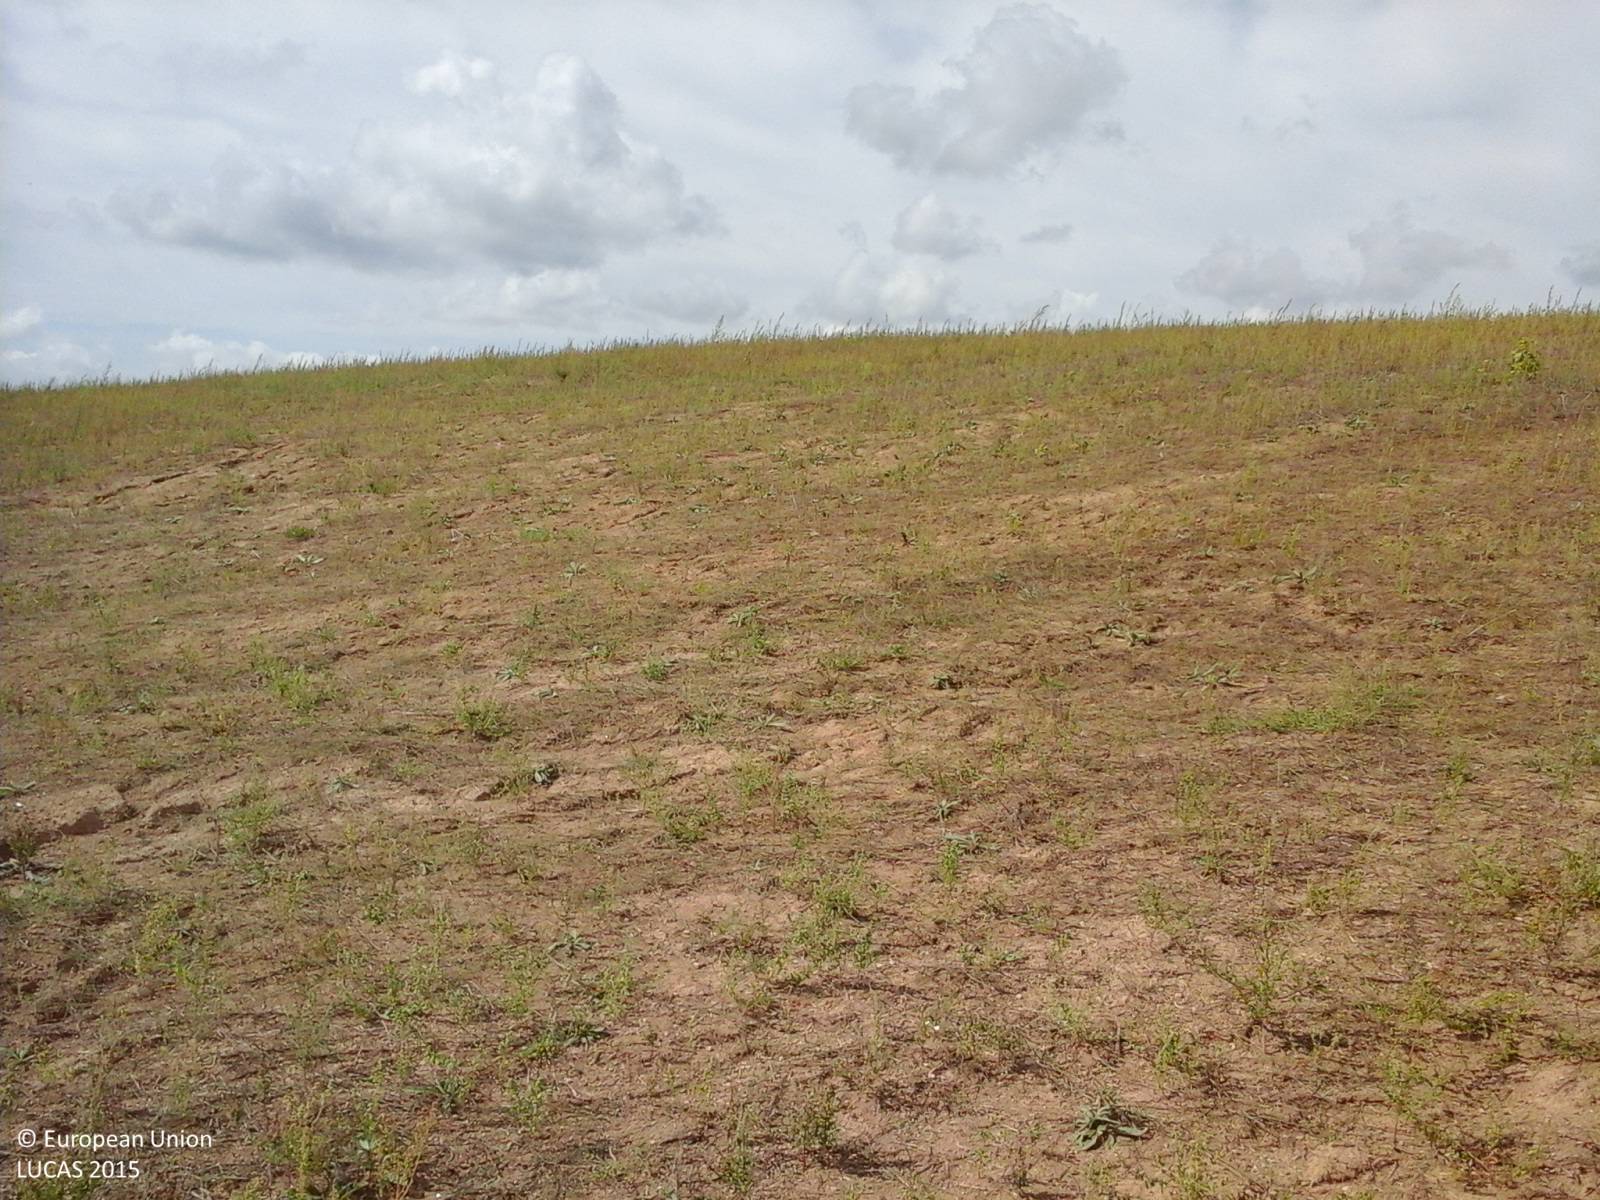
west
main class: Cropland
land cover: Dry pulses
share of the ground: < 10 %
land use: Agriculture (excluding fallow land and kitchen gardens)
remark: Harvested field
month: September
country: IT
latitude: 42.2629
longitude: 12.4524
